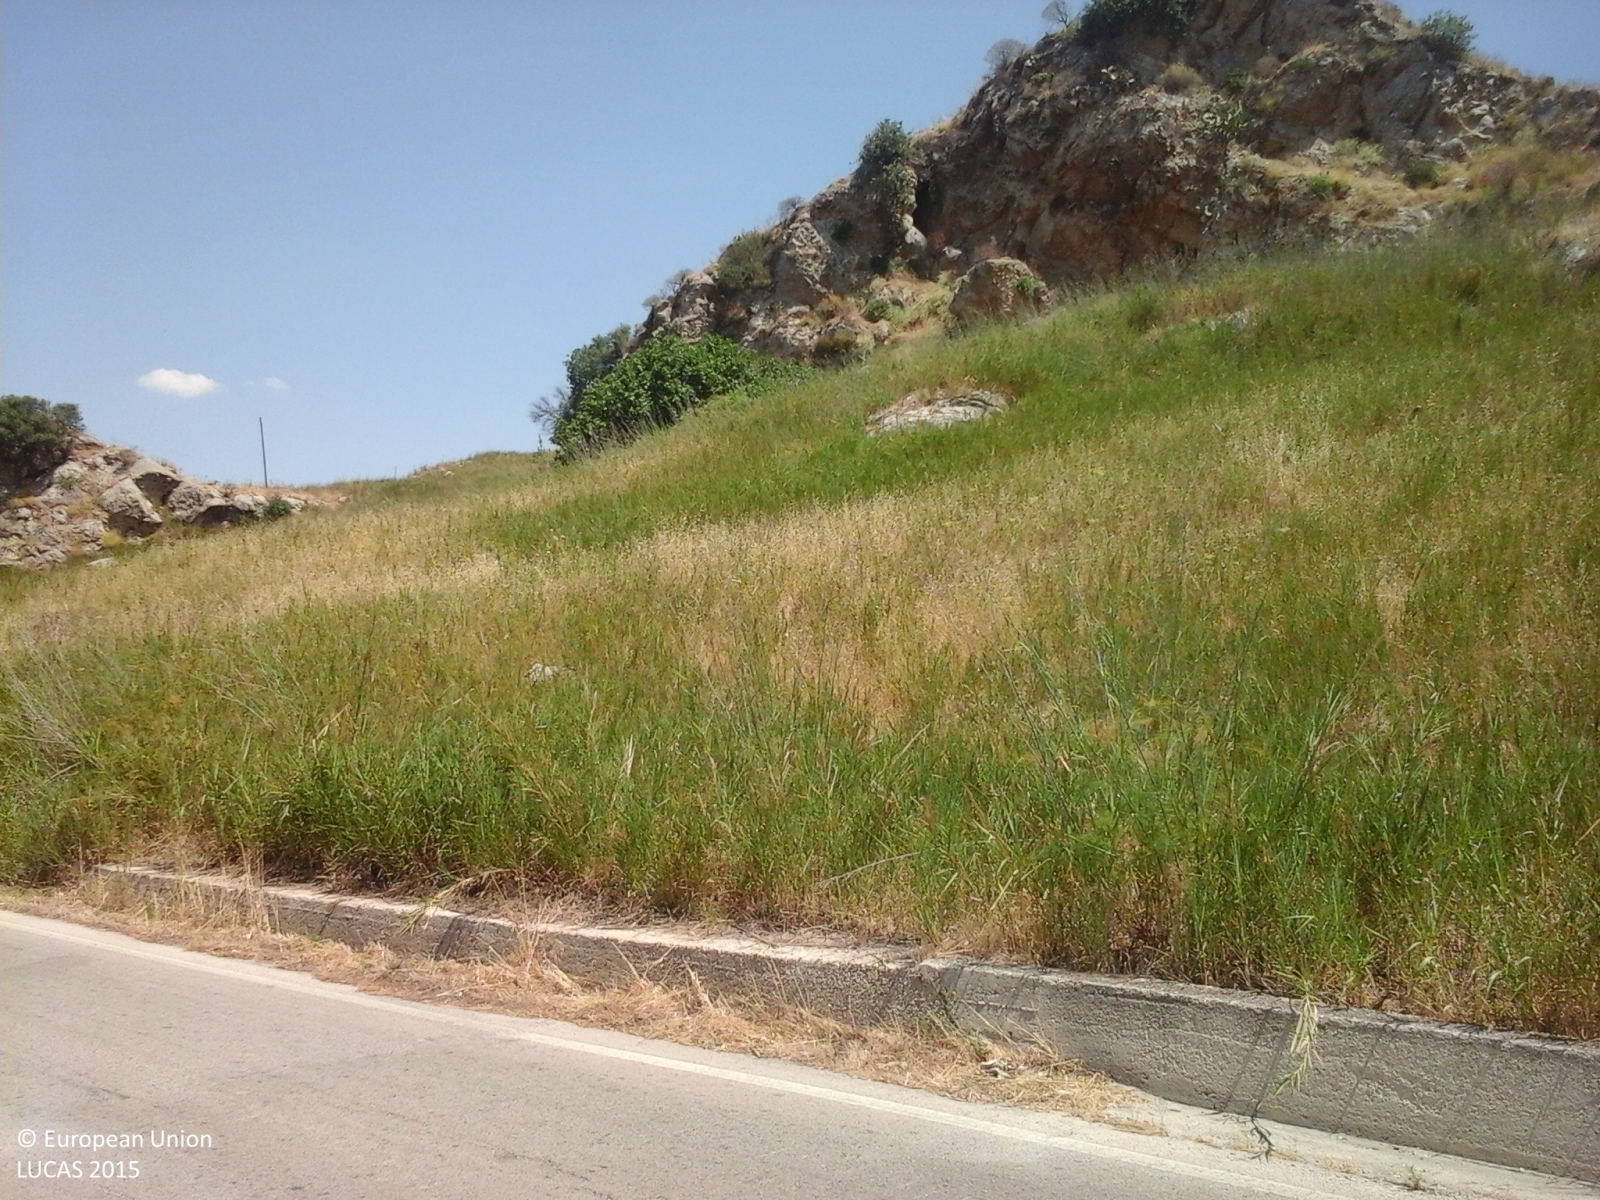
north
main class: Shrubland
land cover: Shrubland without tree cover
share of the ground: > 75 %
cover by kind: herbaceous plants 90 %, shrubs 10 %
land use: Abandoned areas
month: July
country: IT
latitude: 37.4819
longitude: 13.5353
